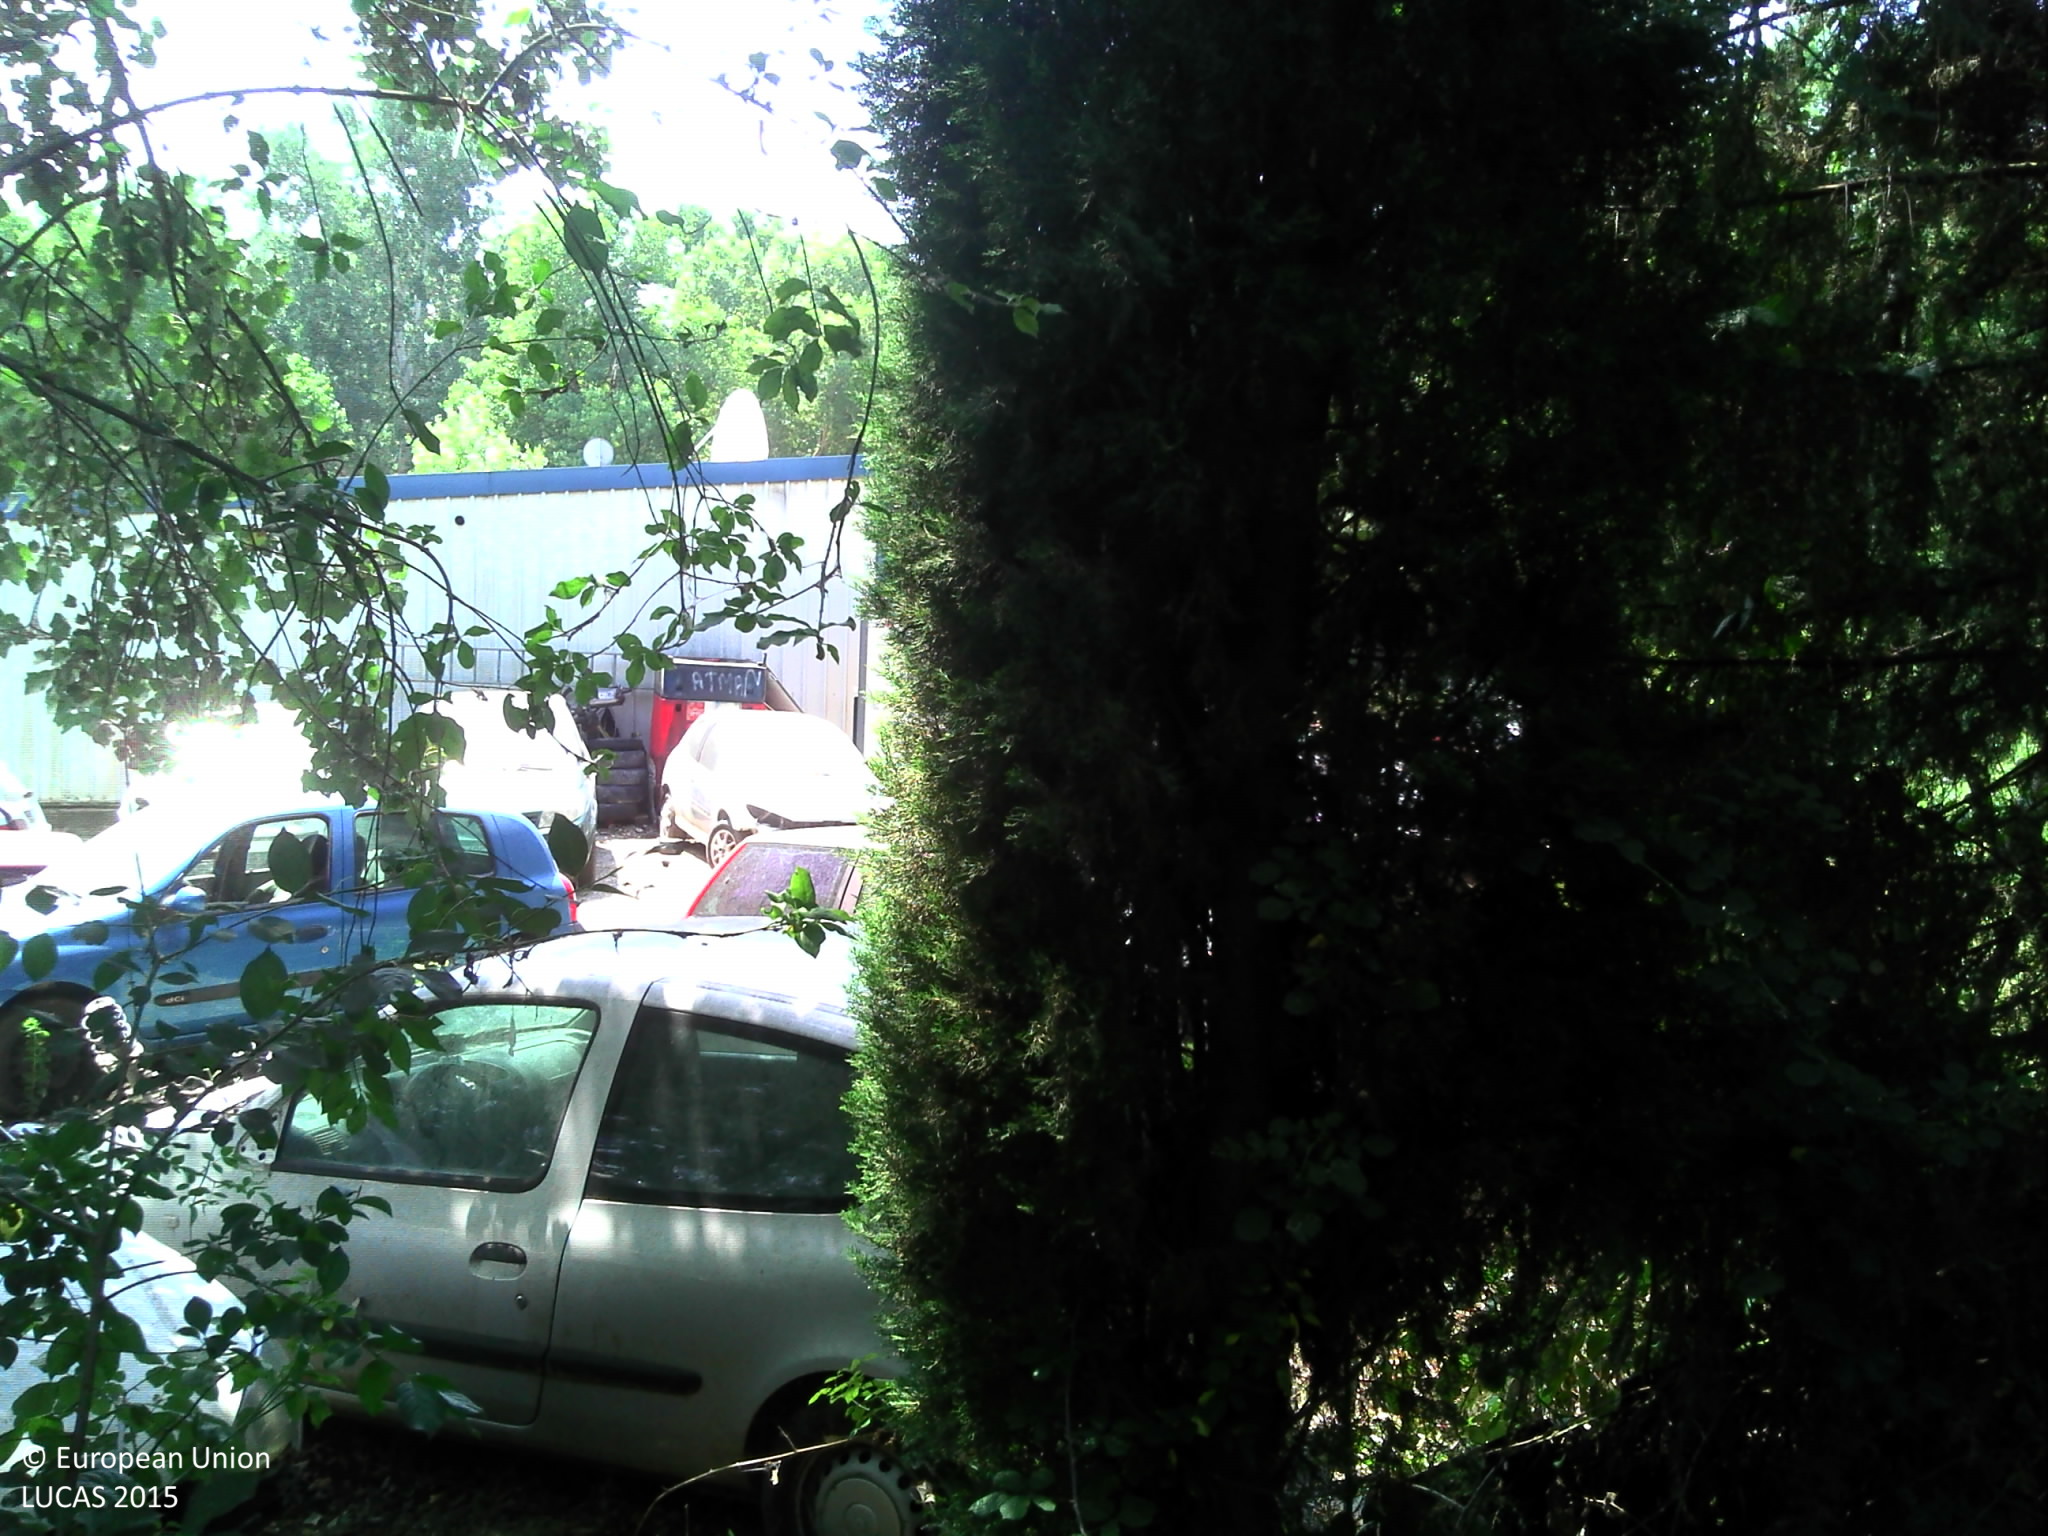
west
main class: Woodland
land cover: Broadleaved woodland
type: floodplain forest
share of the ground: 50 - 75 %
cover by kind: broadleaved forest trees 60 %, shrubs 20 %, coniferous forest trees 10 %, herbaceous plants 10 %
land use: Semi-natural and natural areas not in use
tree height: > 5 m
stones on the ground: < 10 %
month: July
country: FR
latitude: 44.2518
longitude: 4.7100
